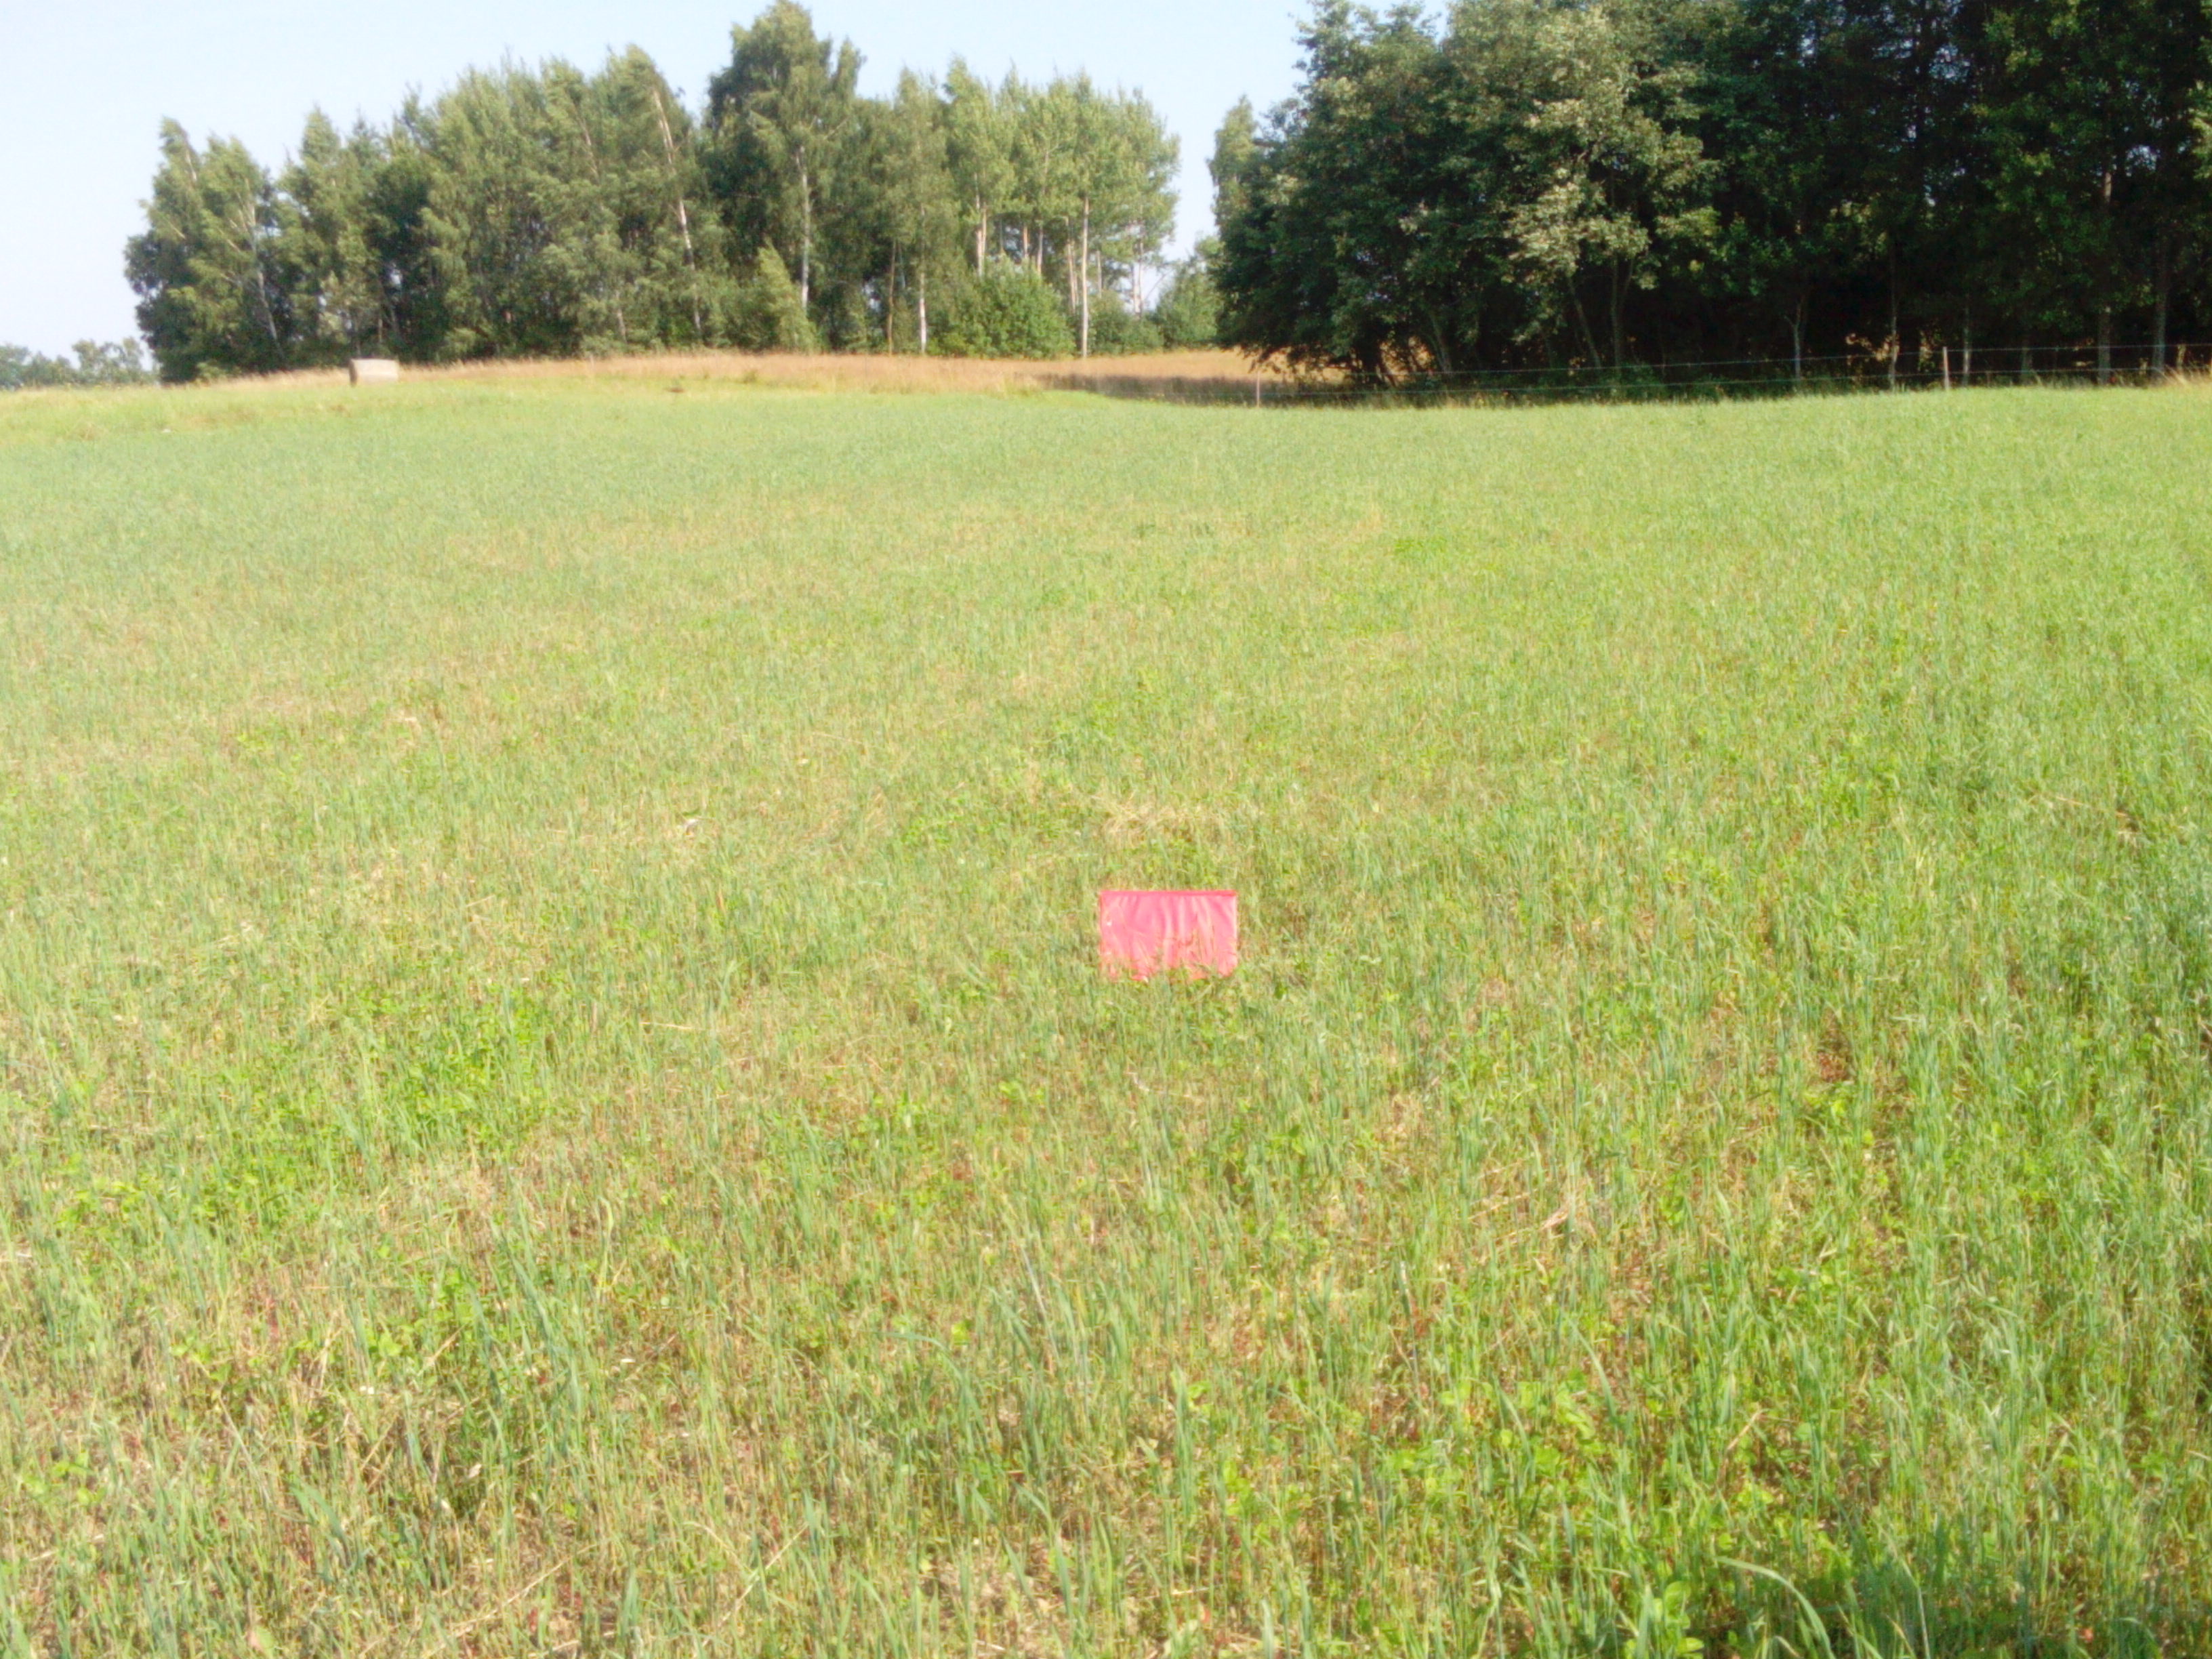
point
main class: Cropland
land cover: Mixed cereals for fodder
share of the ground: > 75 %
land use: Agriculture (excluding fallow land and kitchen gardens)
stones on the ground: < 10 %
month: August
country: LV
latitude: 56.9069
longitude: 21.6862
